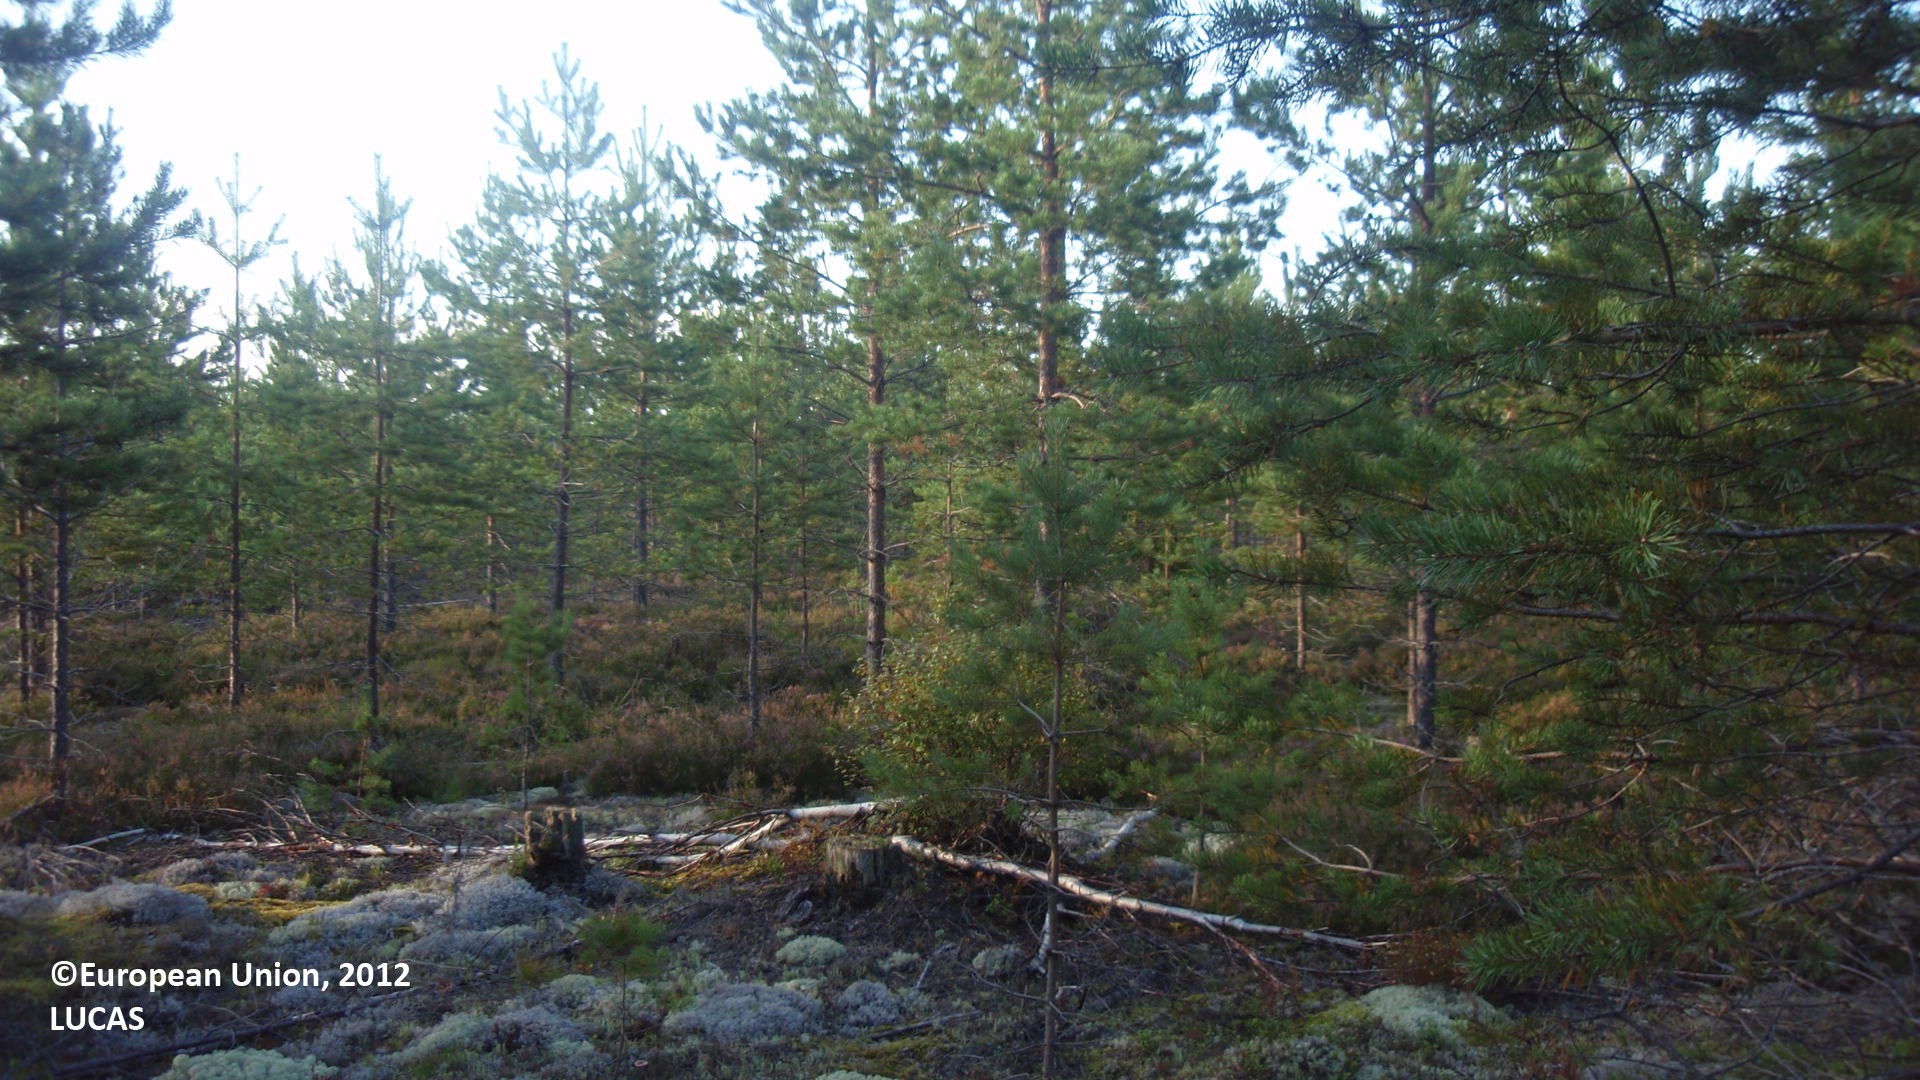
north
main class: Woodland
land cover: Pine dominated coniferous woodland
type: boreal forest
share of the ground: 25 - 50 %
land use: Forestry
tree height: > 5 m
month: August
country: FI
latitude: 60.8113
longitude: 27.5187
